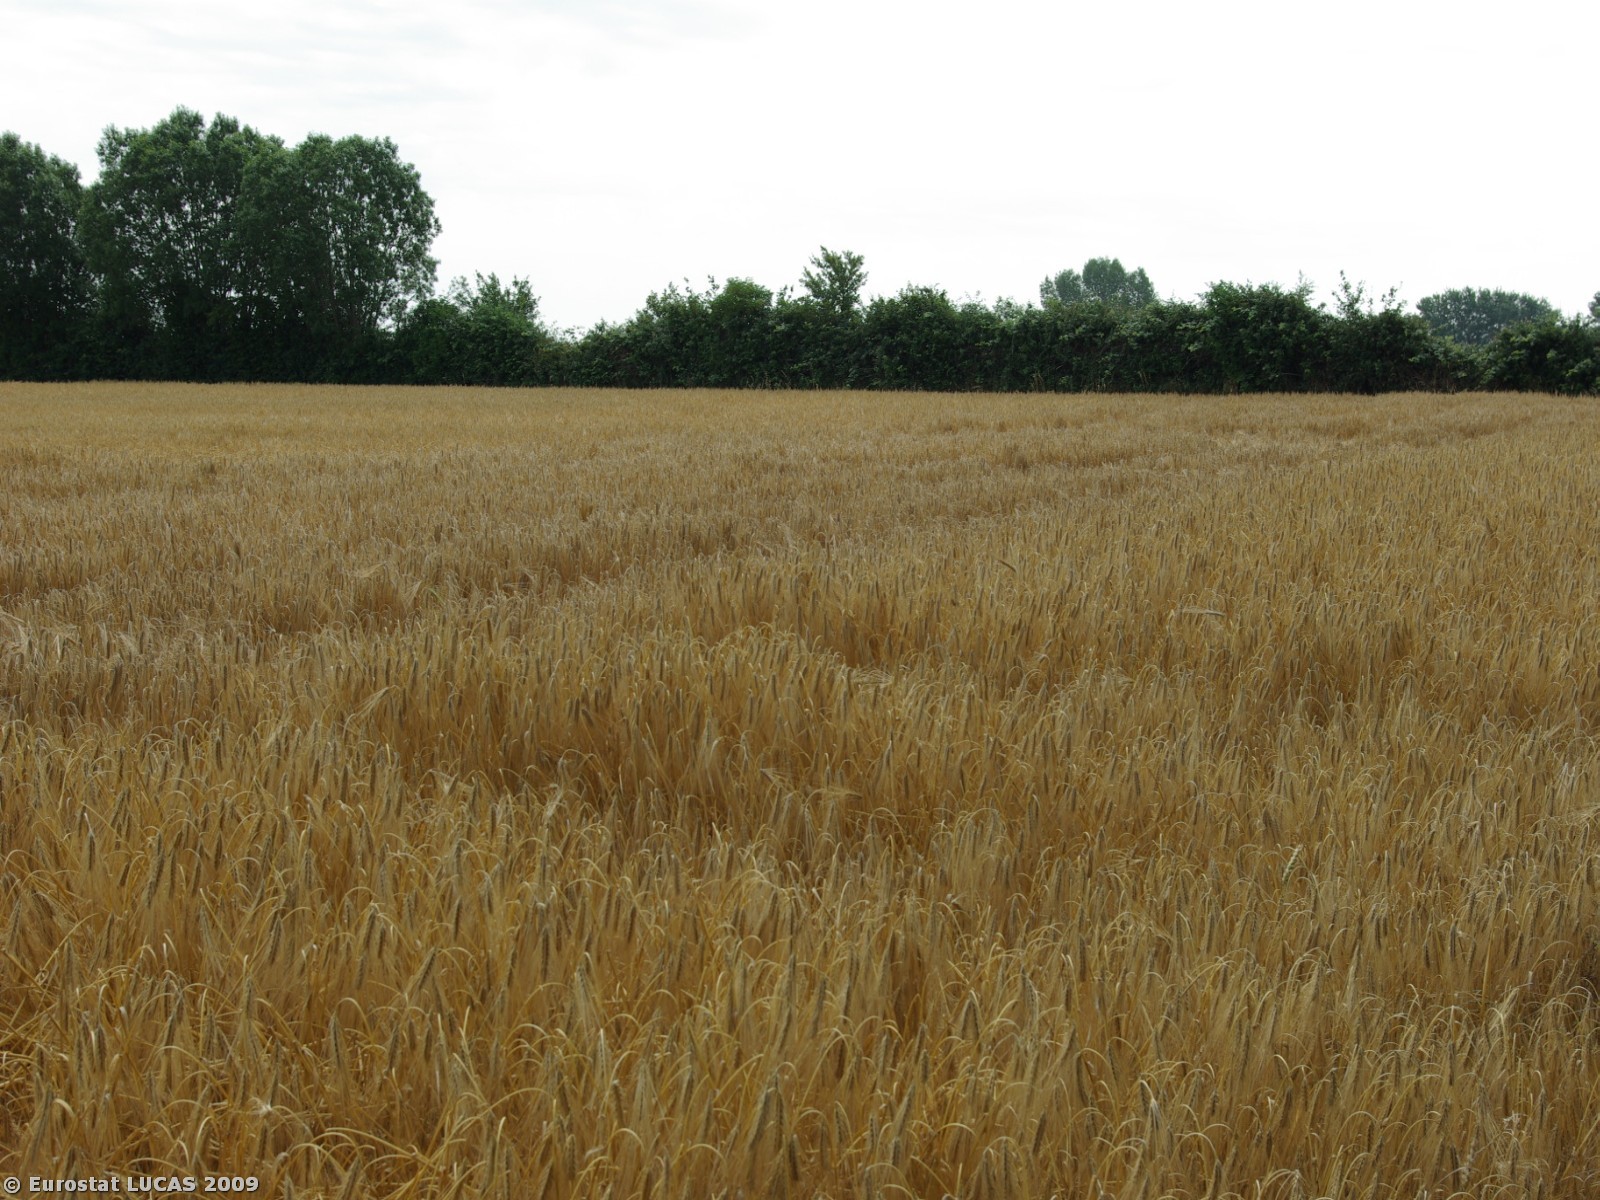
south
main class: Cropland
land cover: Barley
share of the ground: > 75 %
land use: Agriculture (excluding fallow land and kitchen gardens)
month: July
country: DK
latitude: 54.8936
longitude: 10.0467
